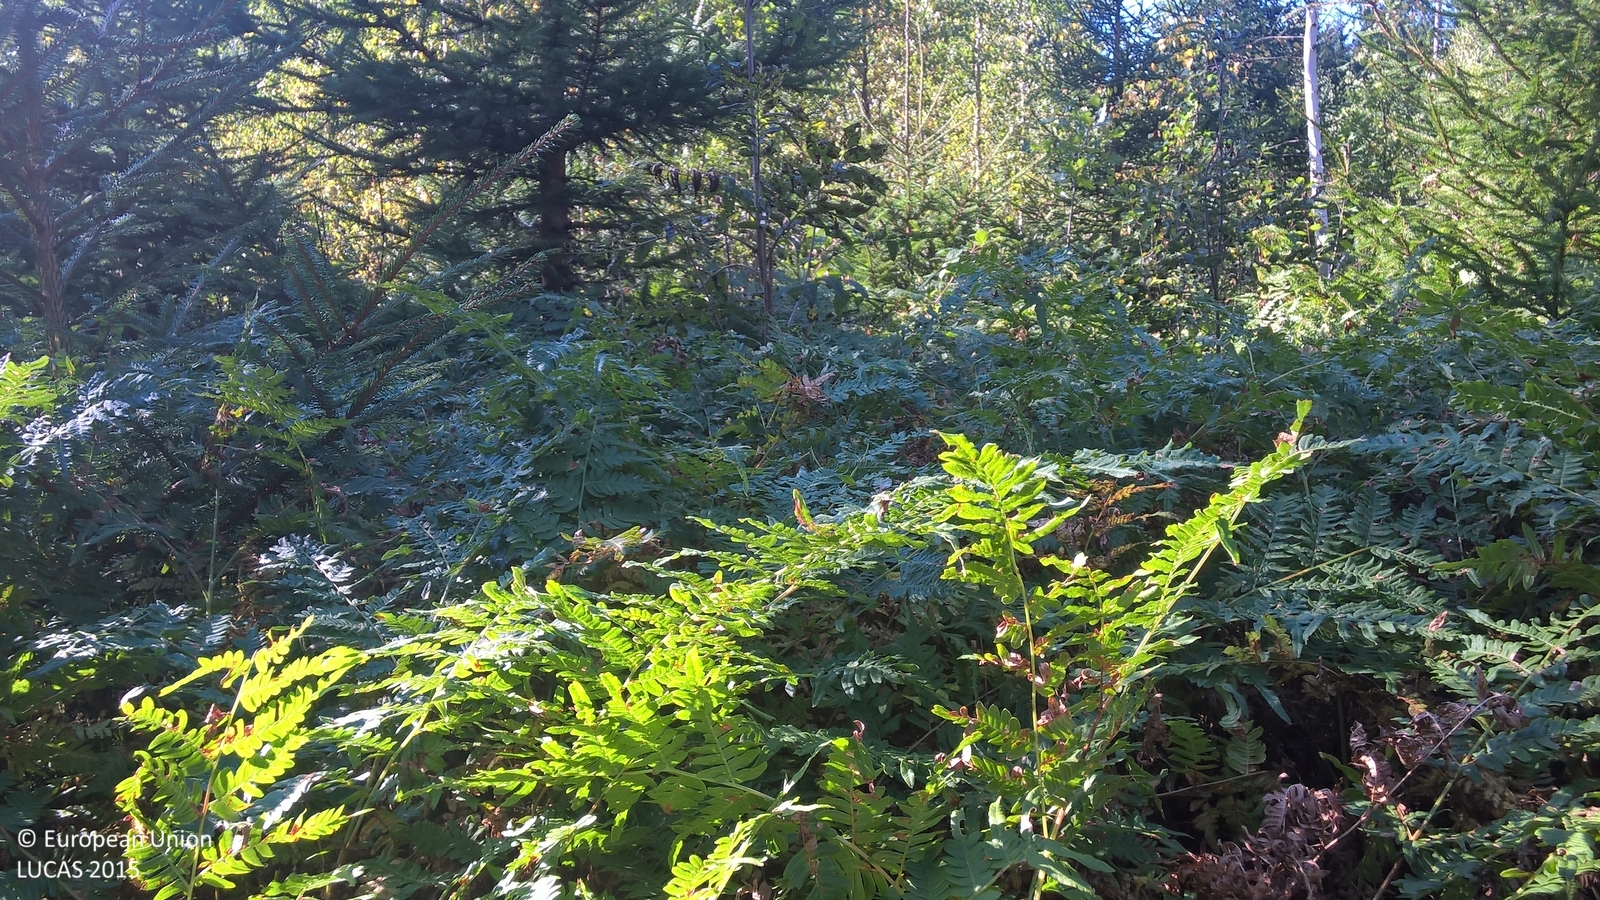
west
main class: Woodland
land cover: Spruce dominated mixed woodland
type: hemiboreal forest and nemoral coniferous forest and mixed broadleaved-coniferous forest
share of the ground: > 75 %
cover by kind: broadleaved forest trees 50 %, coniferous forest trees 30 %, shrubs 10 %, herbaceous plants 10 %
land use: Forestry
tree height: > 5 m
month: September
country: LV
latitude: 57.3948
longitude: 25.5755
